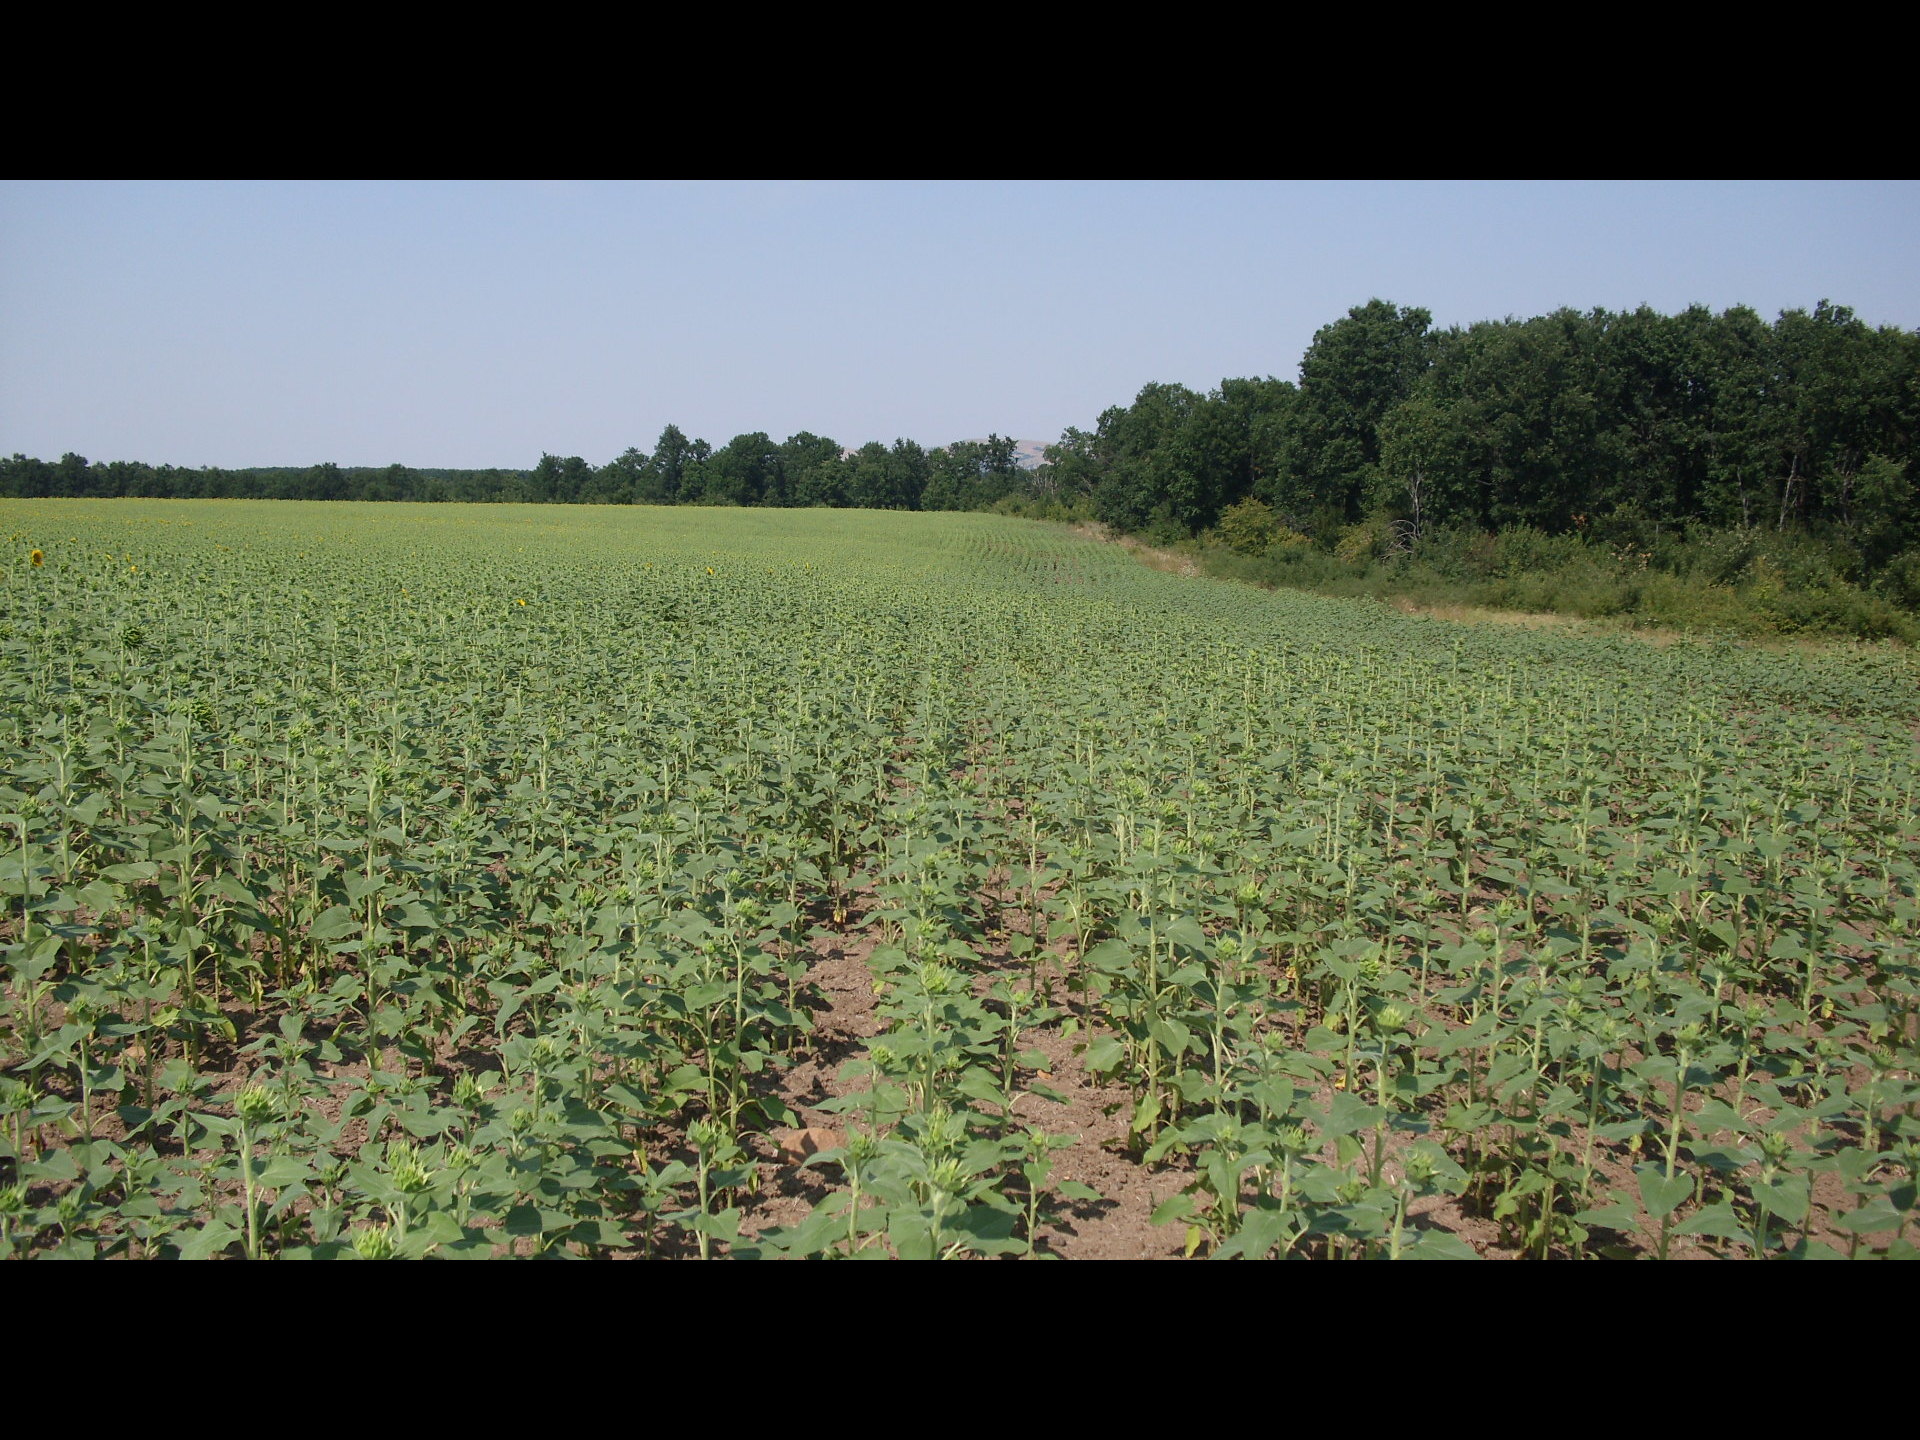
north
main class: Cropland
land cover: Sunflower
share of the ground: 25 - 50 %
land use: Agriculture (excluding fallow land and kitchen gardens)
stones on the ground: < 10 %
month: August
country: BG
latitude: 43.3470
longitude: 23.2767
